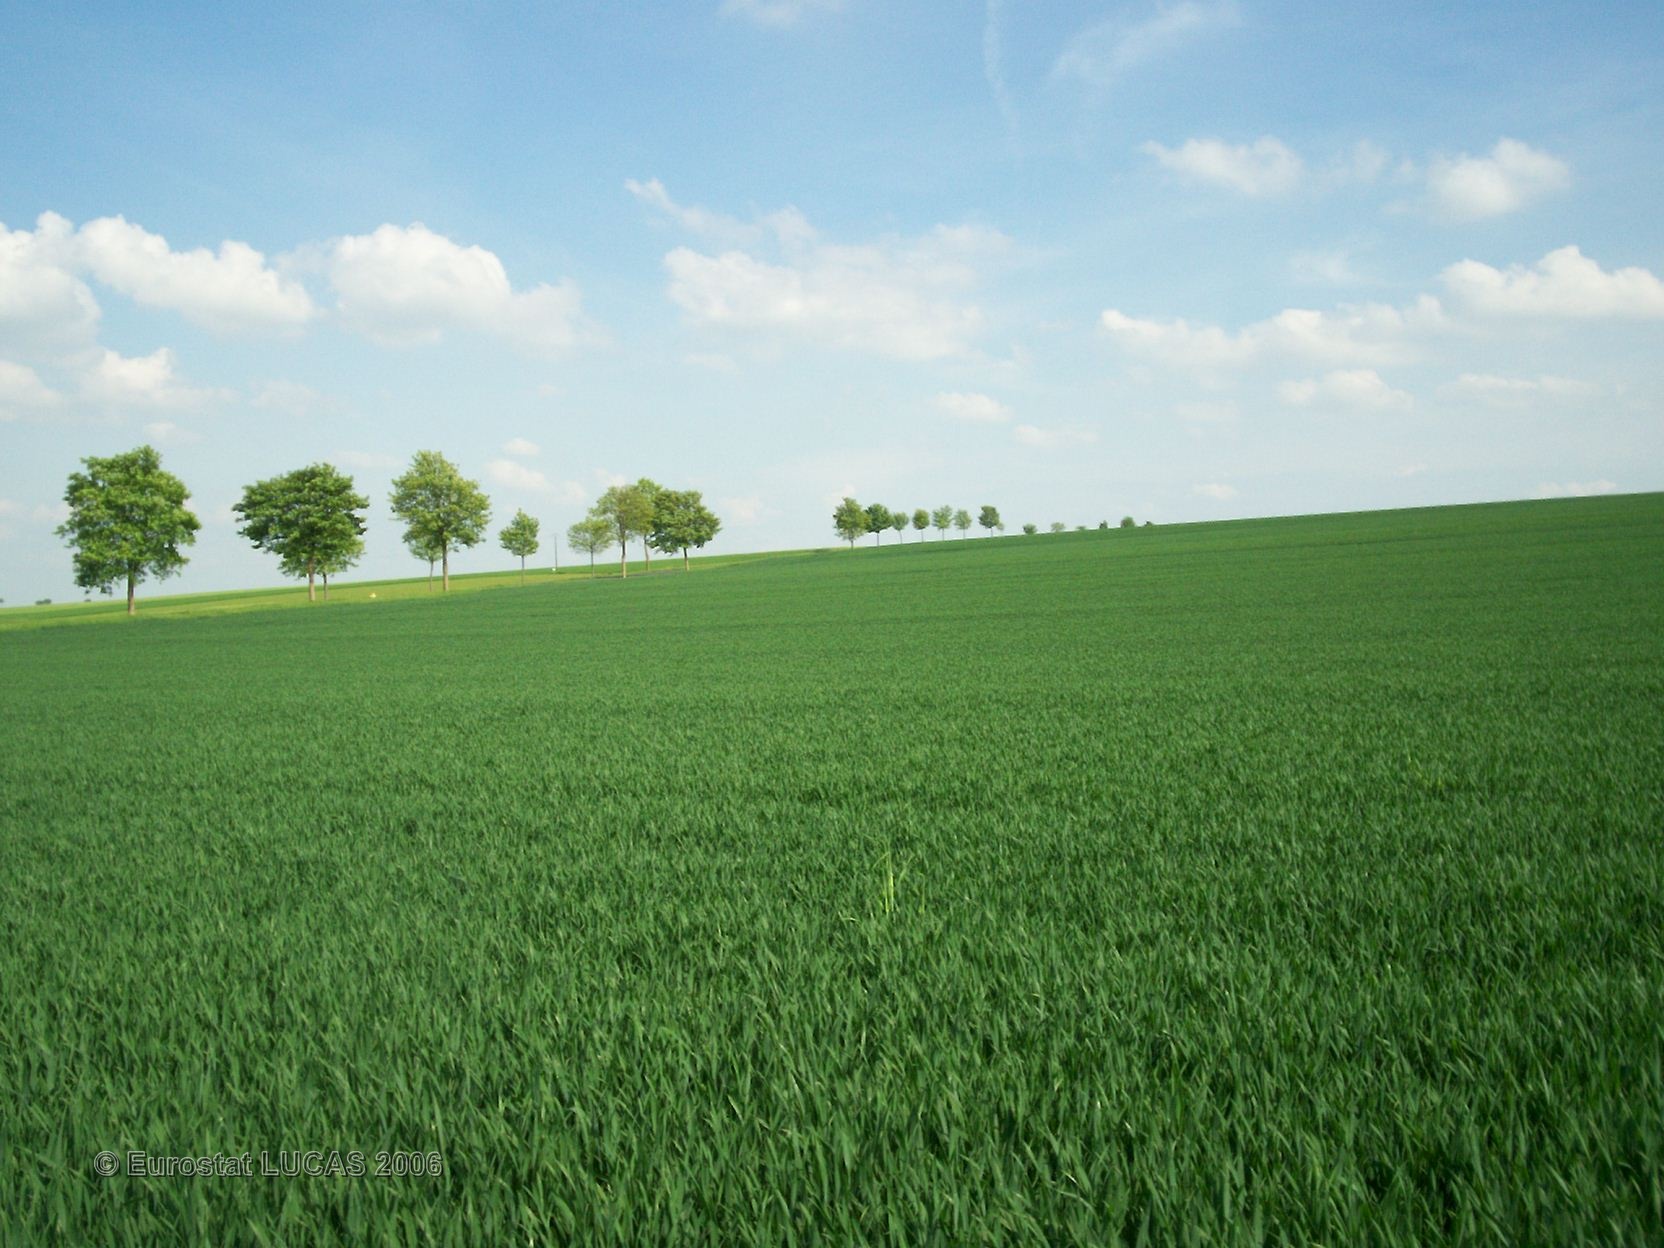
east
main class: Cropland
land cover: Common wheat
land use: Agriculture (excluding fallow land and kitchen gardens)
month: May
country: FR
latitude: 48.8923
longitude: 4.3907
